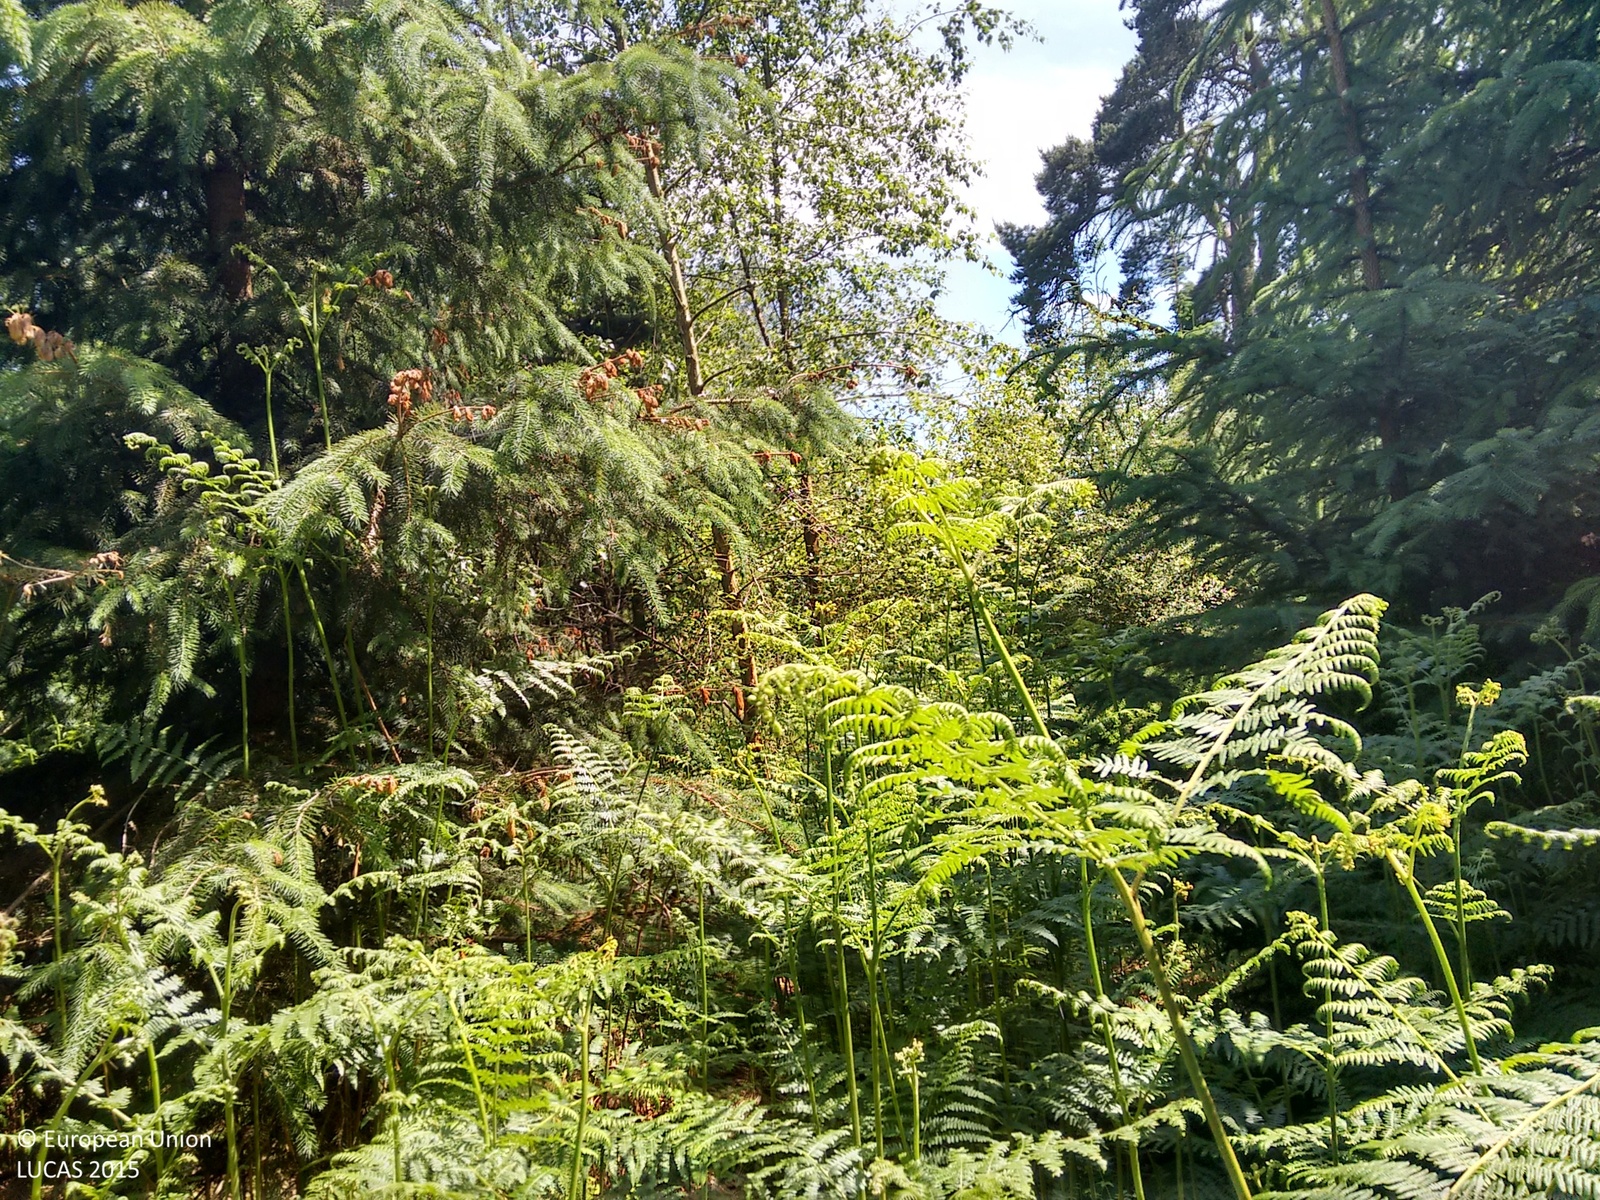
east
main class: Woodland
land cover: Spruce dominated mixed woodland
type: exotic forest
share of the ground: > 75 %
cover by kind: coniferous forest trees 75 %, broadleaved forest trees 25 %
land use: Forestry
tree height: > 5 m
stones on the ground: < 10 %
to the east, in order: Spruce dominated mixed woodland; Inland marshes; Rivers and streams; Grassland without tree/shrub cover; Inland marshes; Broadleaved woodland; Spruce dominated coniferous woodland
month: July
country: GB
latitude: 55.0011
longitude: -3.4461
